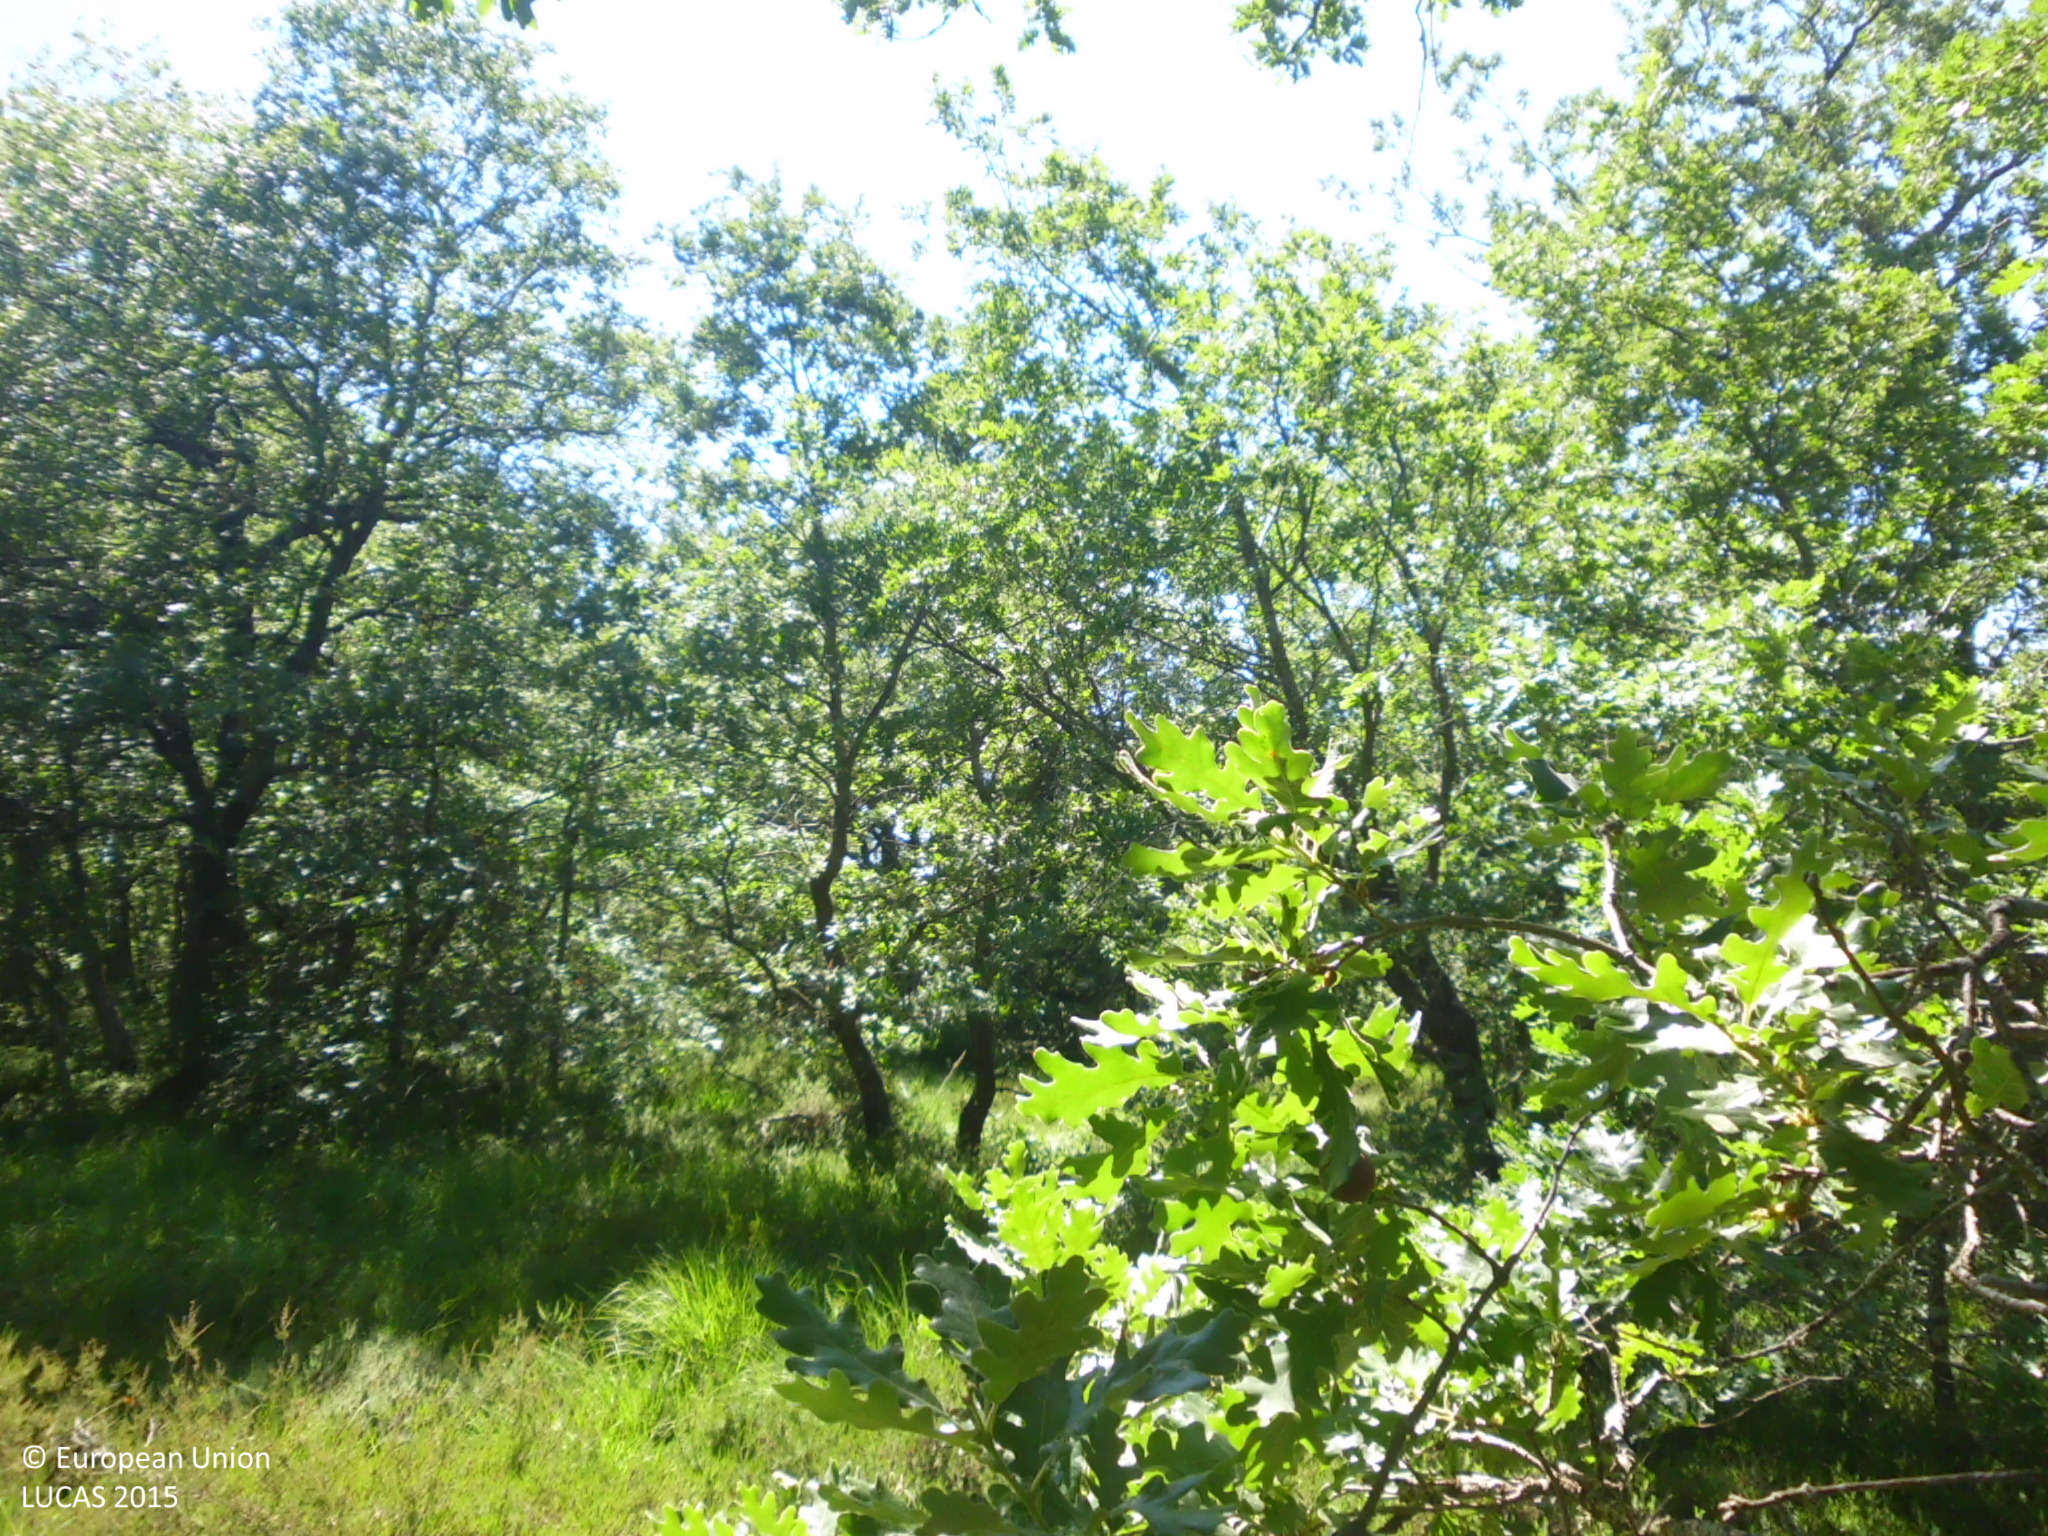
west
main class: Woodland
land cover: Broadleaved woodland
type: acidophilous oak and oak-birch forest
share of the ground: 25 - 50 %
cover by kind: broadleaved forest trees 40 %, shrubs 40 %, consolidated bare surface 15 %, herbaceous plants 5 %
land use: Semi-natural and natural areas not in use
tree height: > 5 m
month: June
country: ES
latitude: 42.6237
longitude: -4.0293
